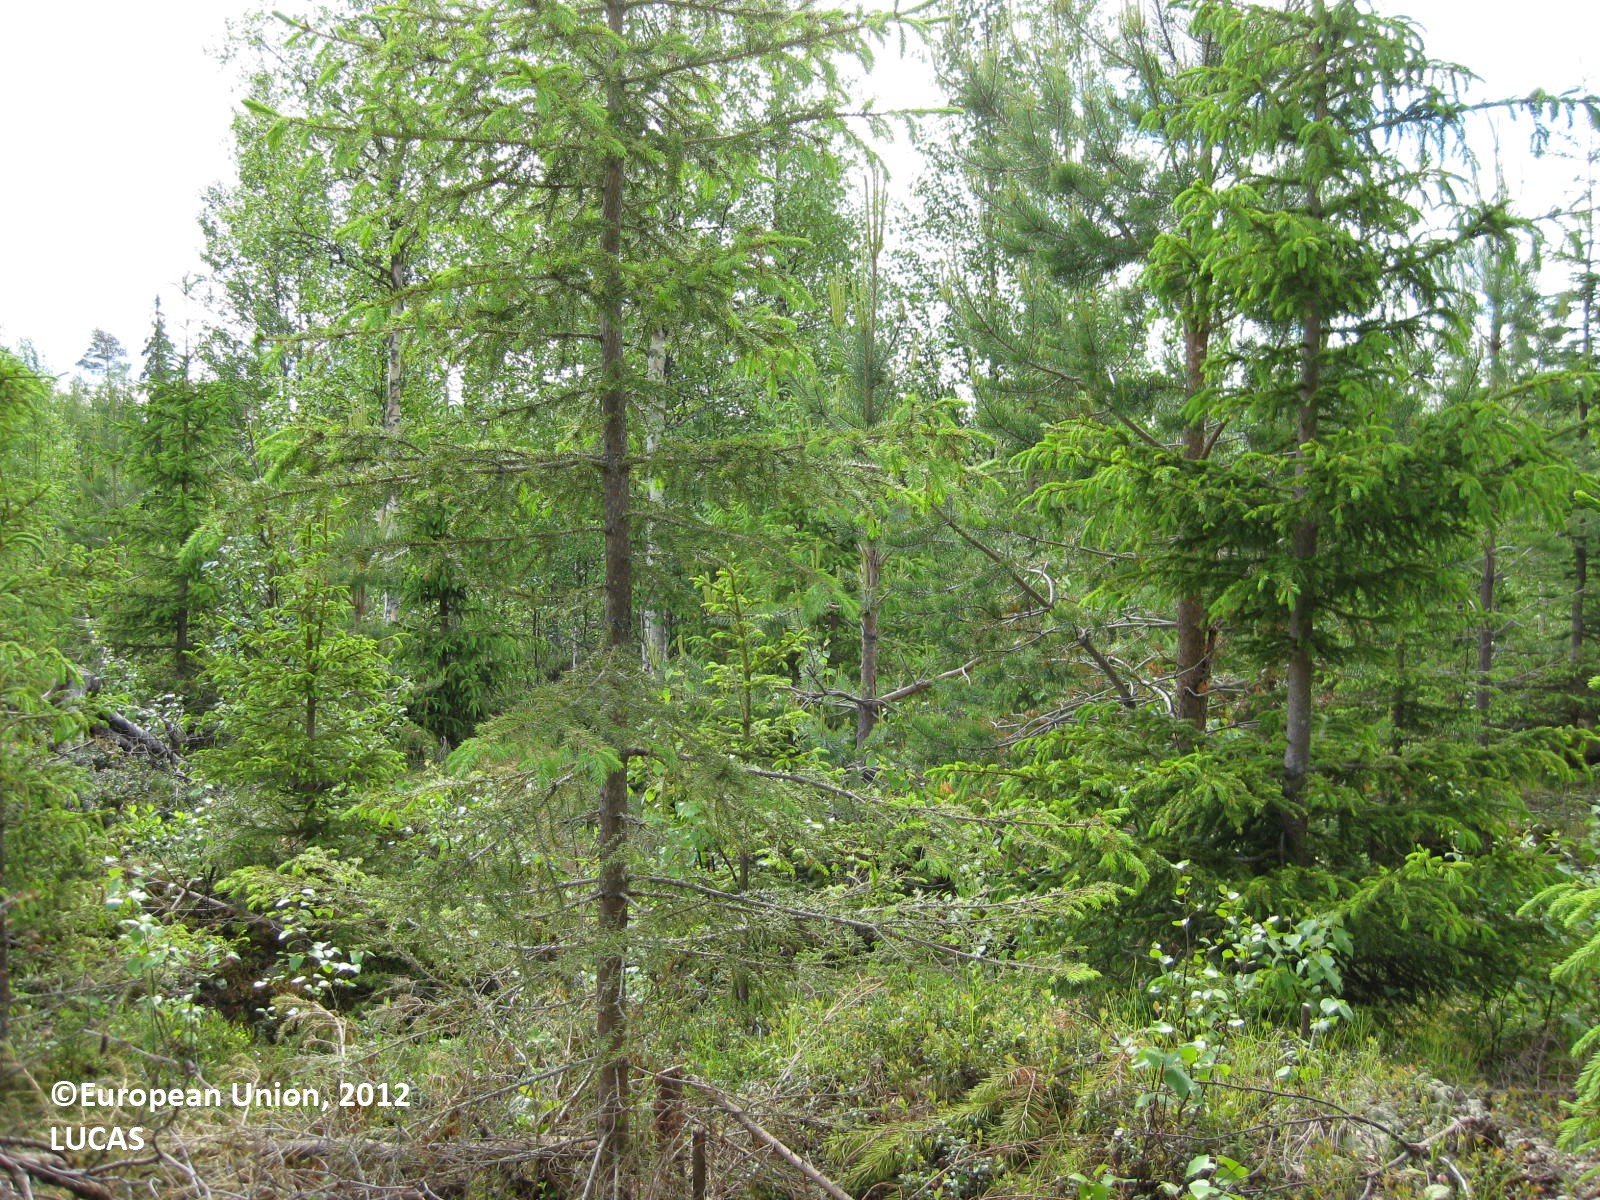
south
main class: Woodland
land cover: Spruce dominated mixed woodland
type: boreal forest
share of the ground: 50 - 75 %
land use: Forestry
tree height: > 5 m
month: June
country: FI
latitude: 65.3523
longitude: 28.3165
